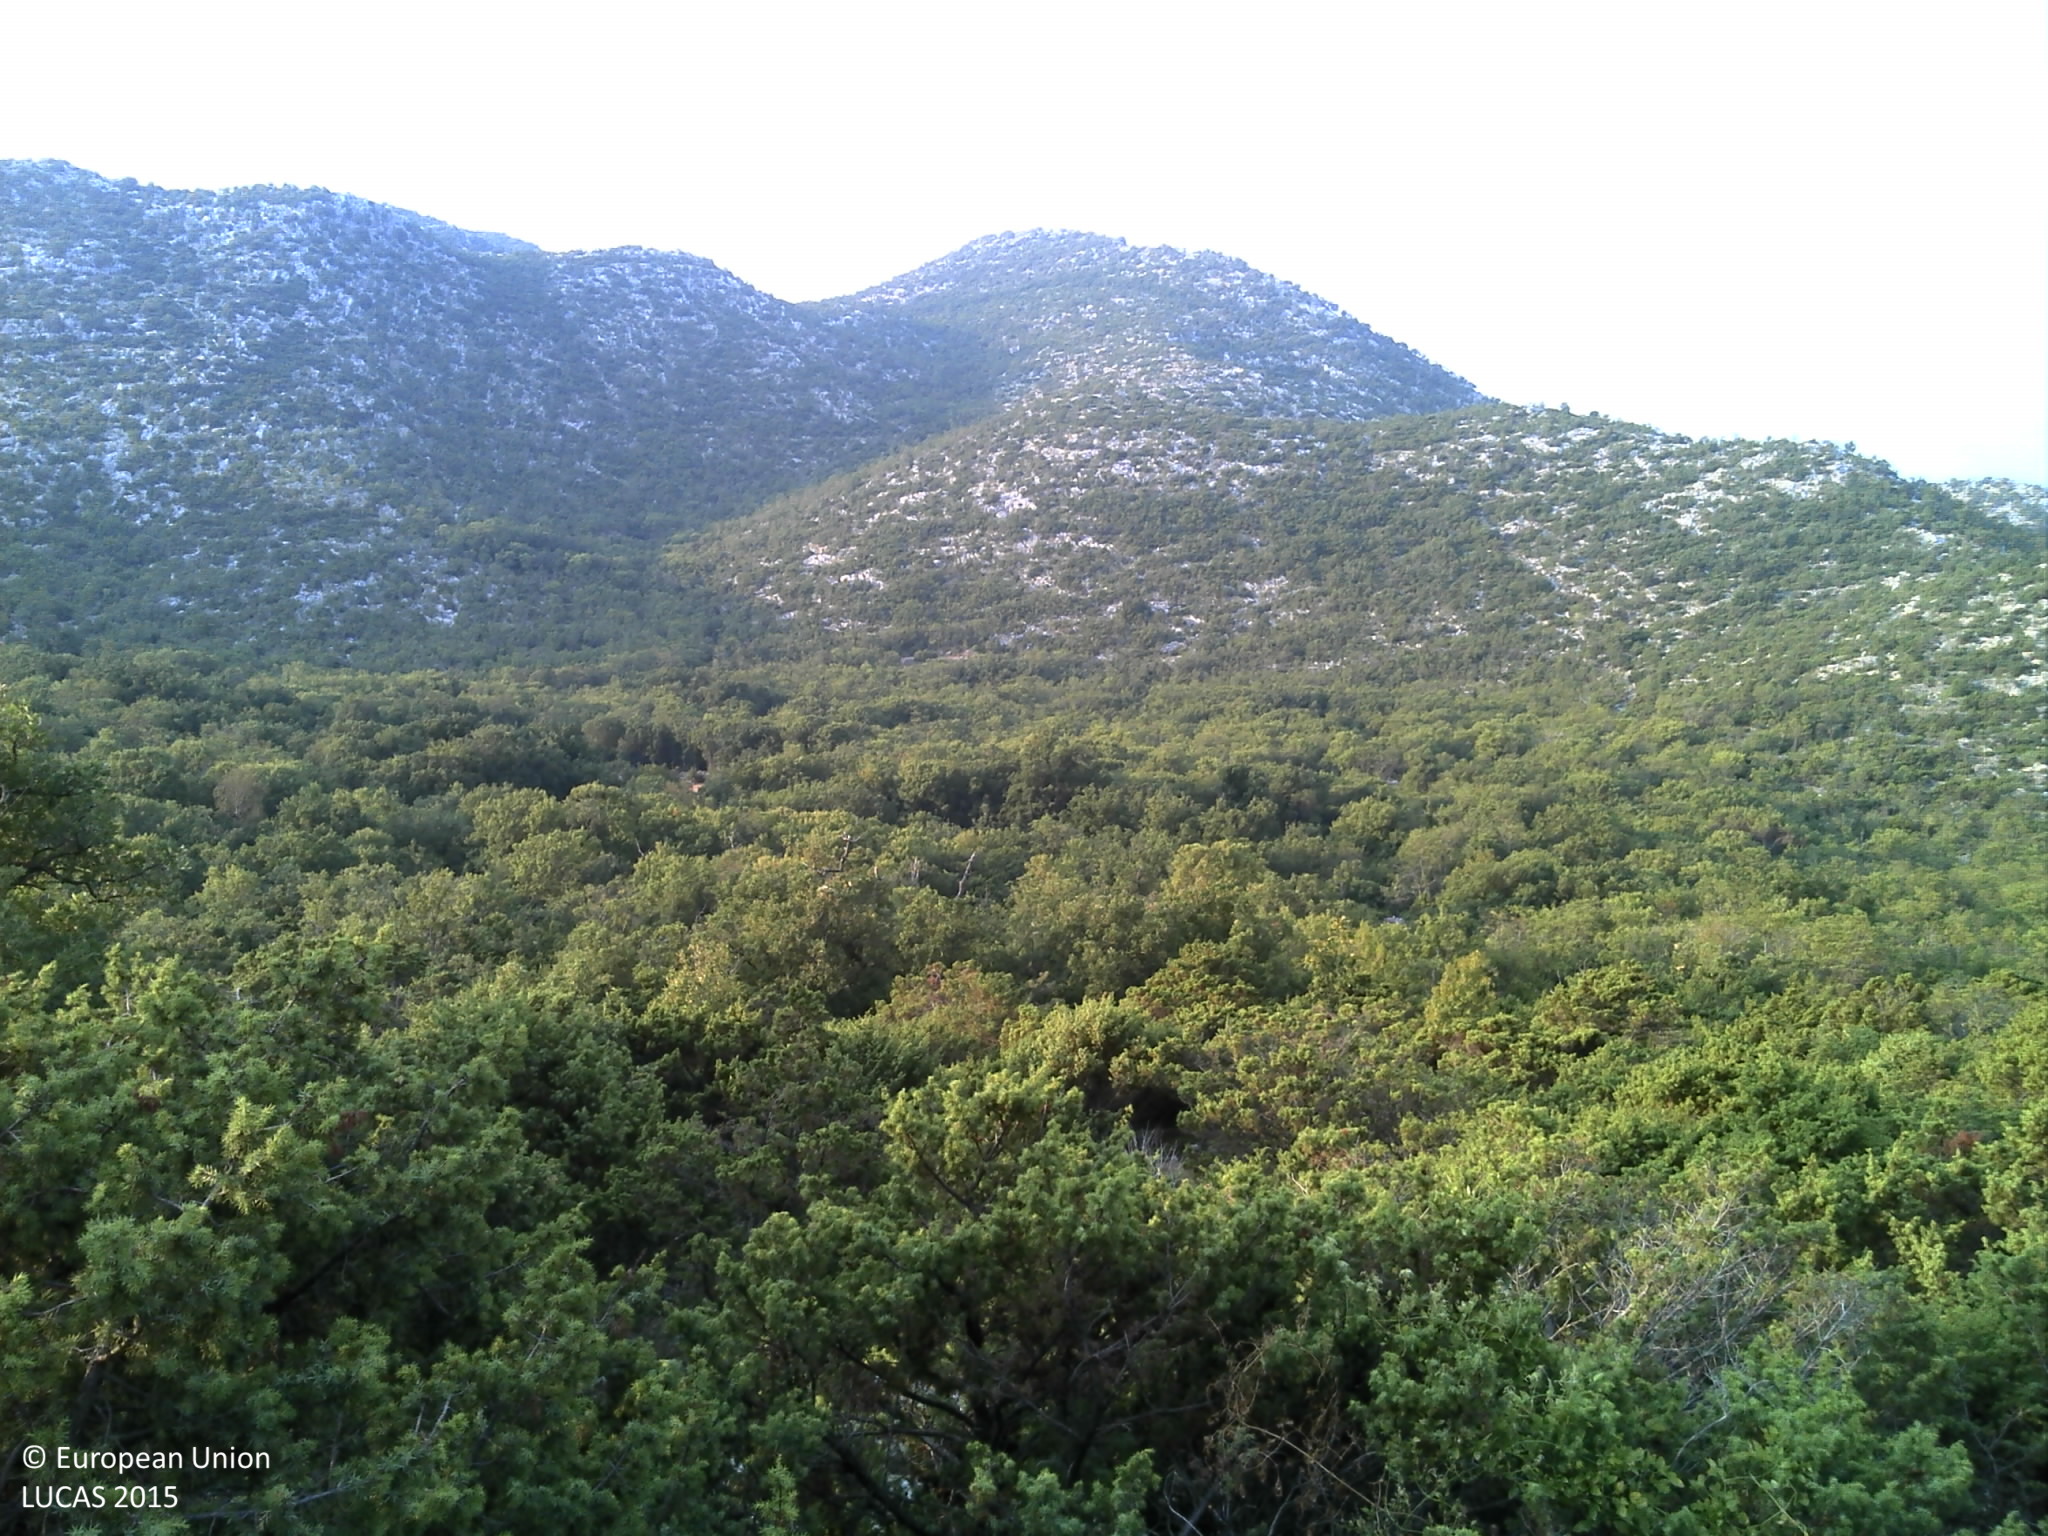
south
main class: Shrubland
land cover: Shrubland with sparse tree cover
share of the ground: 50 - 75 %
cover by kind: shrubs 50 %, unconsolidated bare surface 25 %, herbaceous plants 10 %, consolidated bare surface 10 %, broadleaved forest trees 5 %
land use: Agriculture (excluding fallow land and kitchen gardens)
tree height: < 5 m
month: August
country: HR
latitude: 43.2367
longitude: 17.1206
